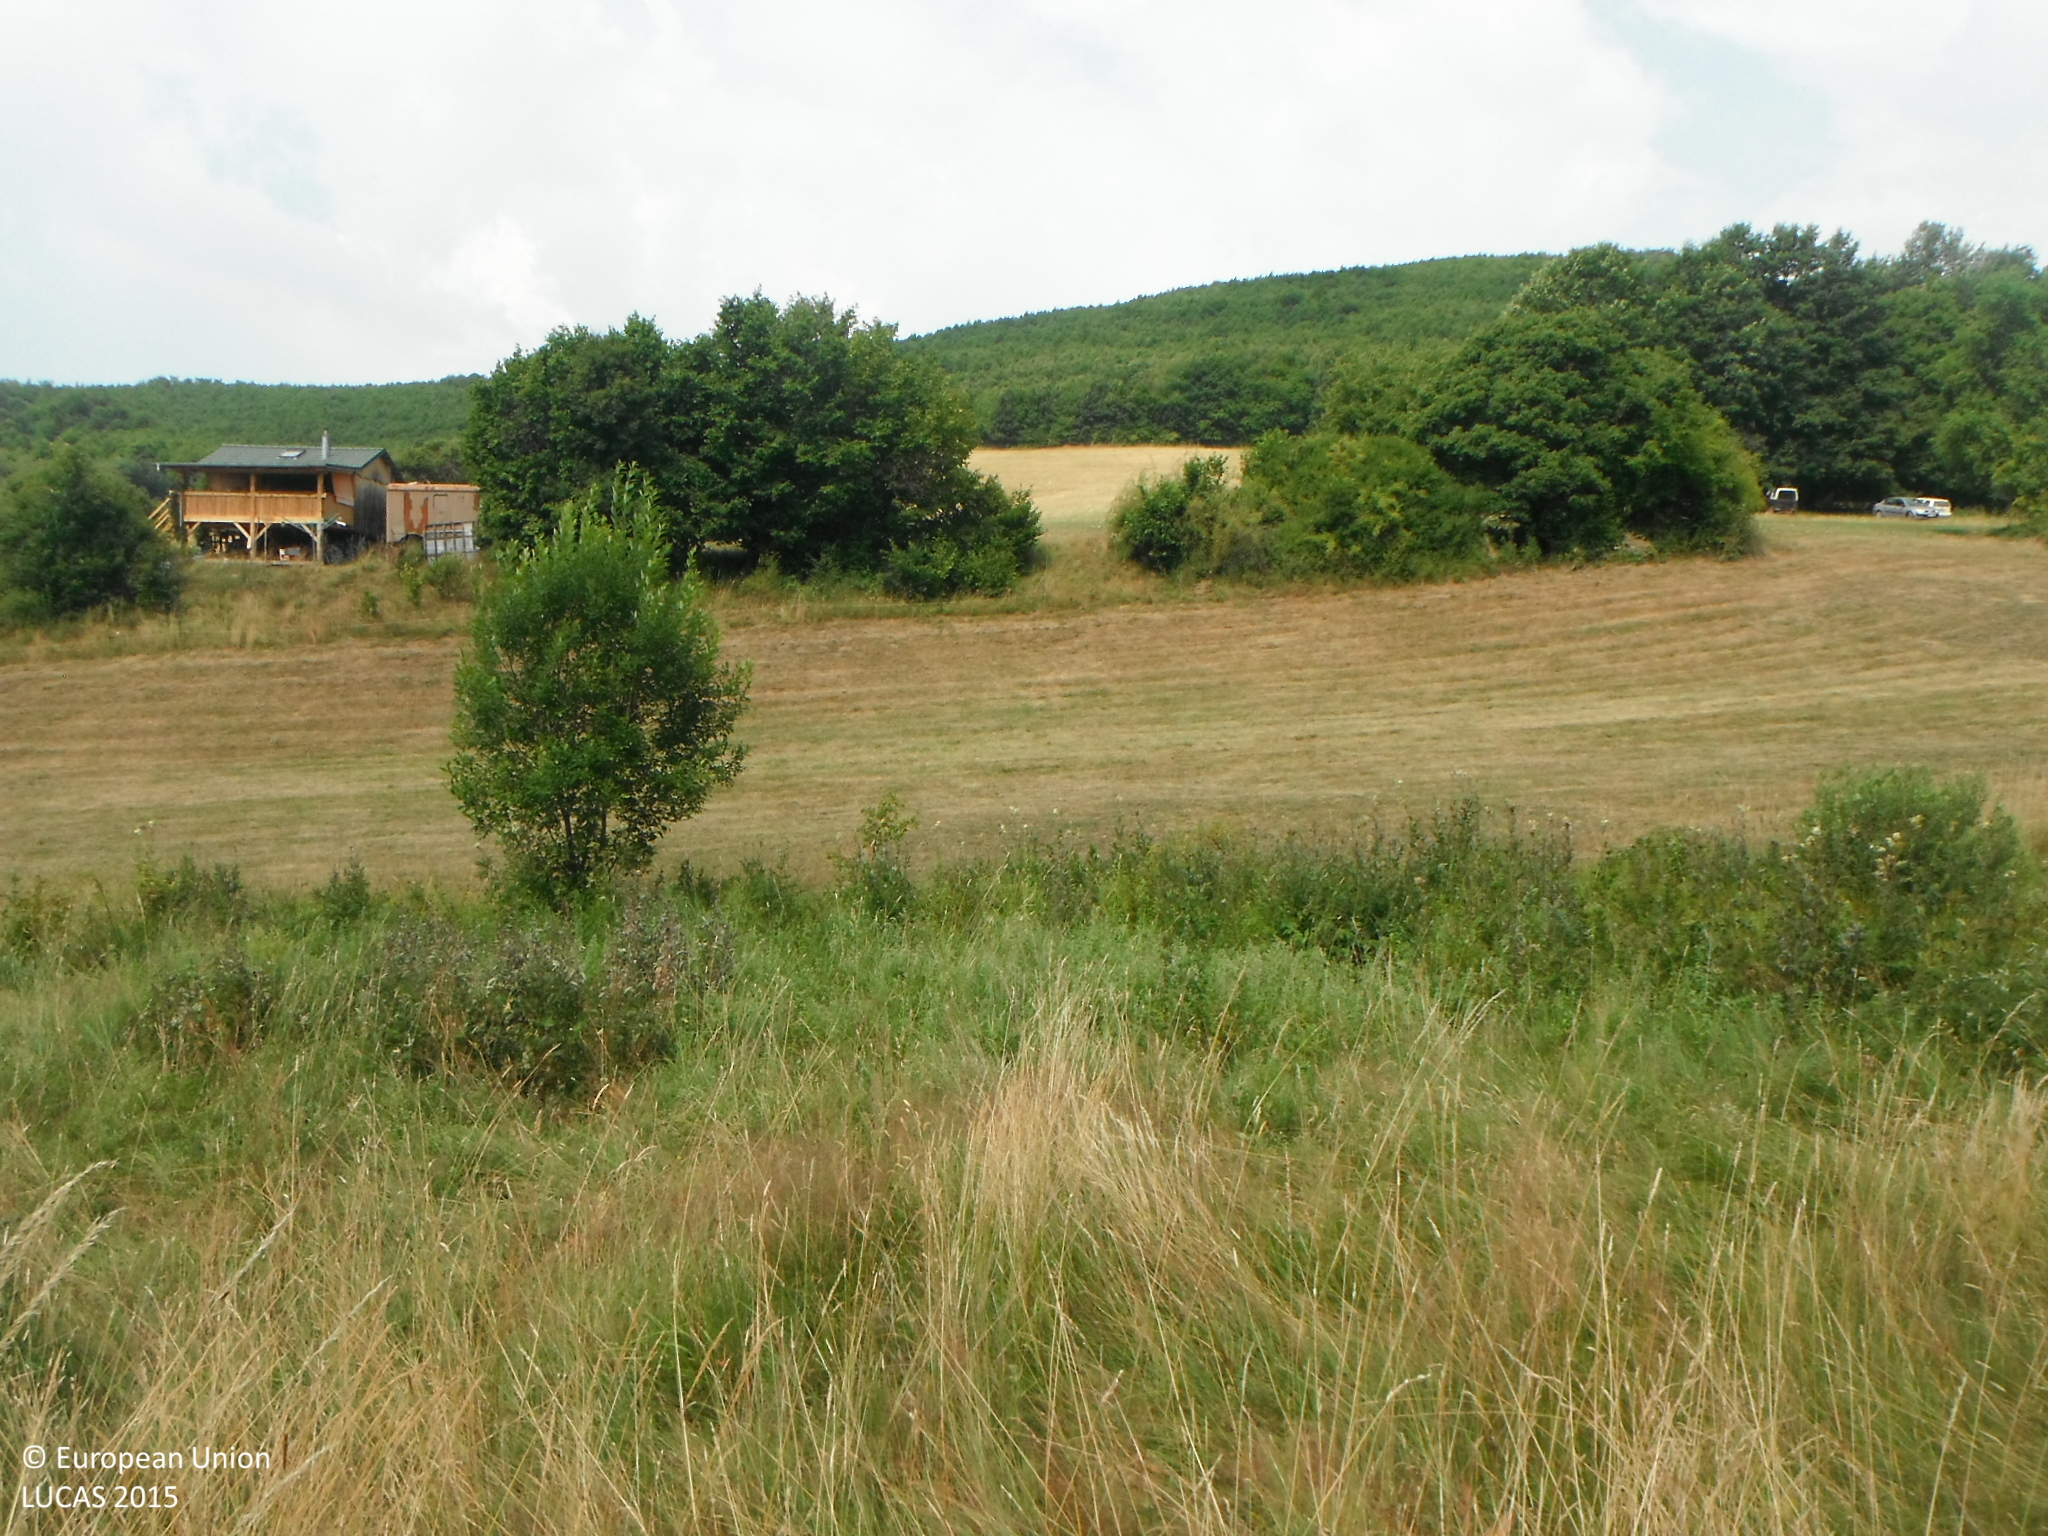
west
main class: Grassland
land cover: Grassland without tree/shrub cover
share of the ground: > 75 %
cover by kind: herbaceous plants 100 %
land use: Agriculture (excluding fallow land and kitchen gardens)
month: July
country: SK
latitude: 48.4714
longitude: 19.2064
